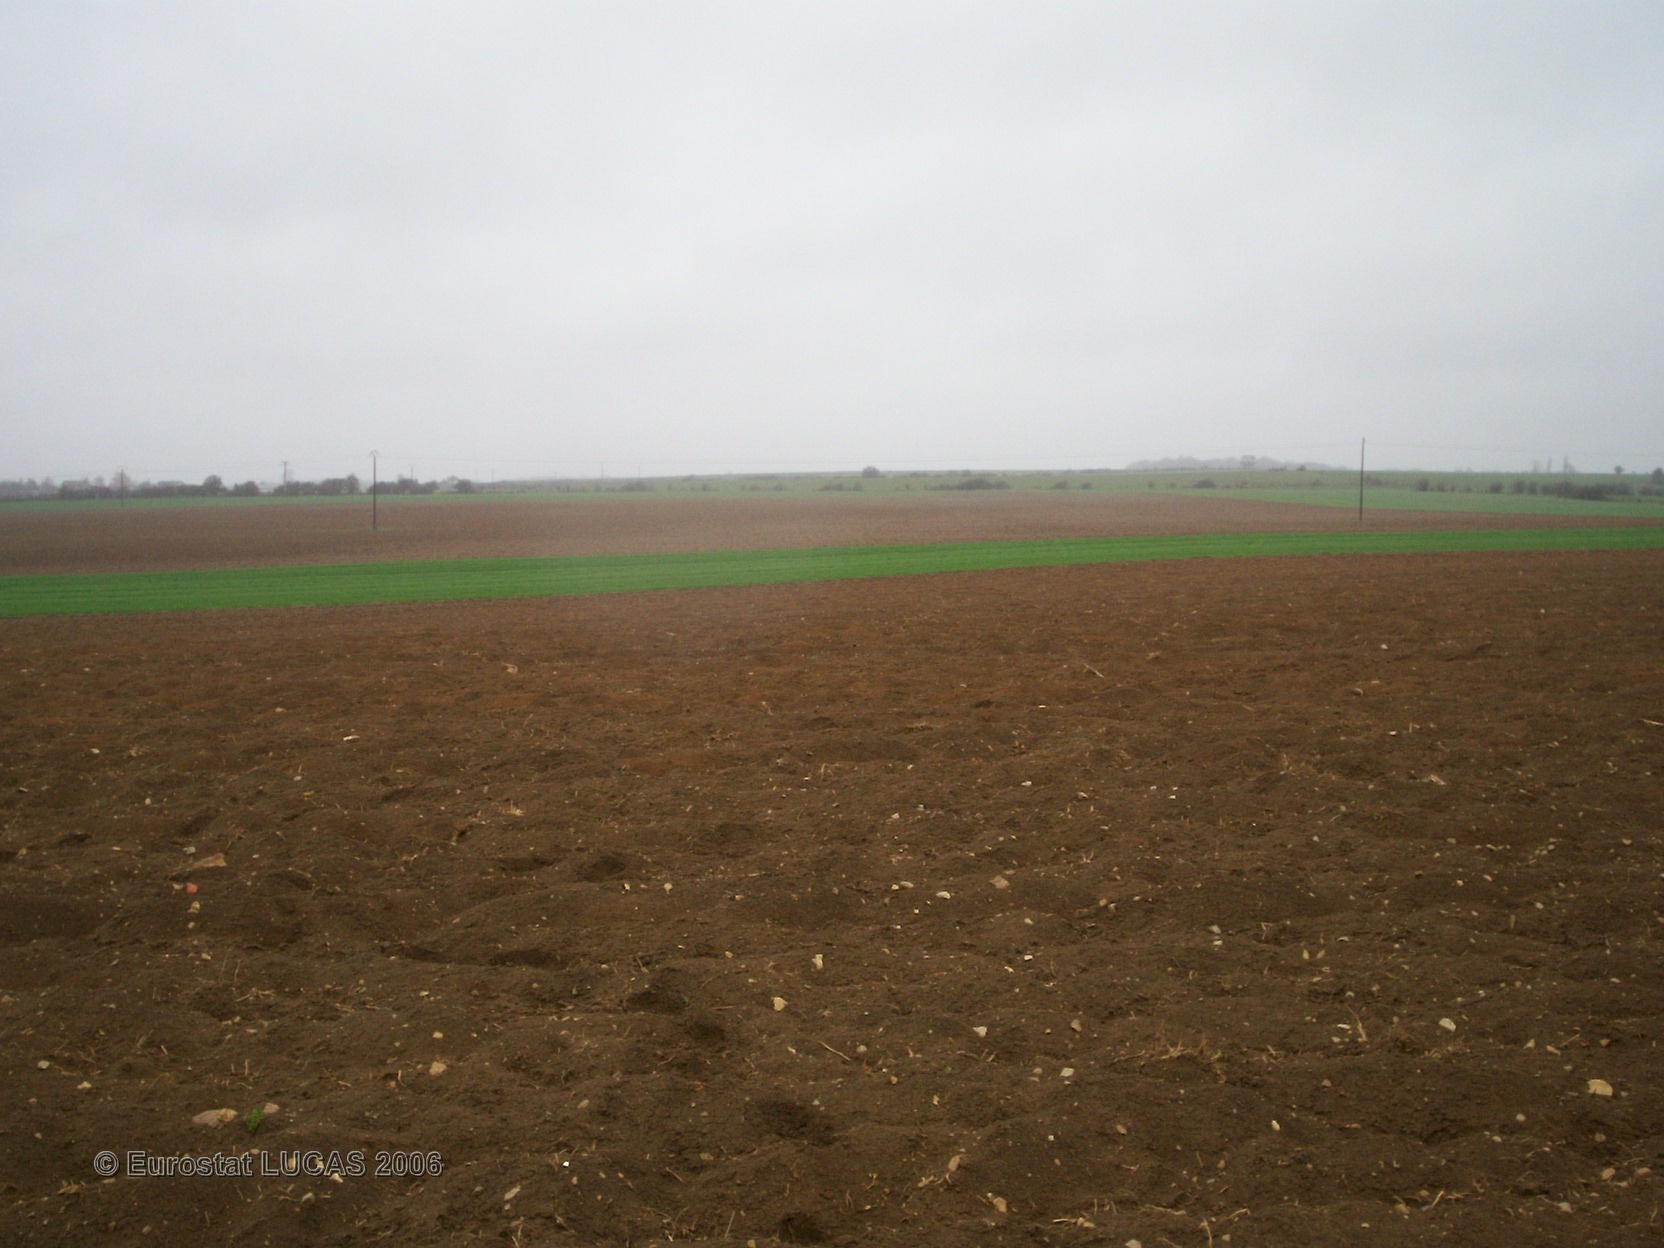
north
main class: Cropland
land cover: Maize
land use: Agriculture (excluding fallow land and kitchen gardens)
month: May
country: FR
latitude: 48.6854
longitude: 6.9443
